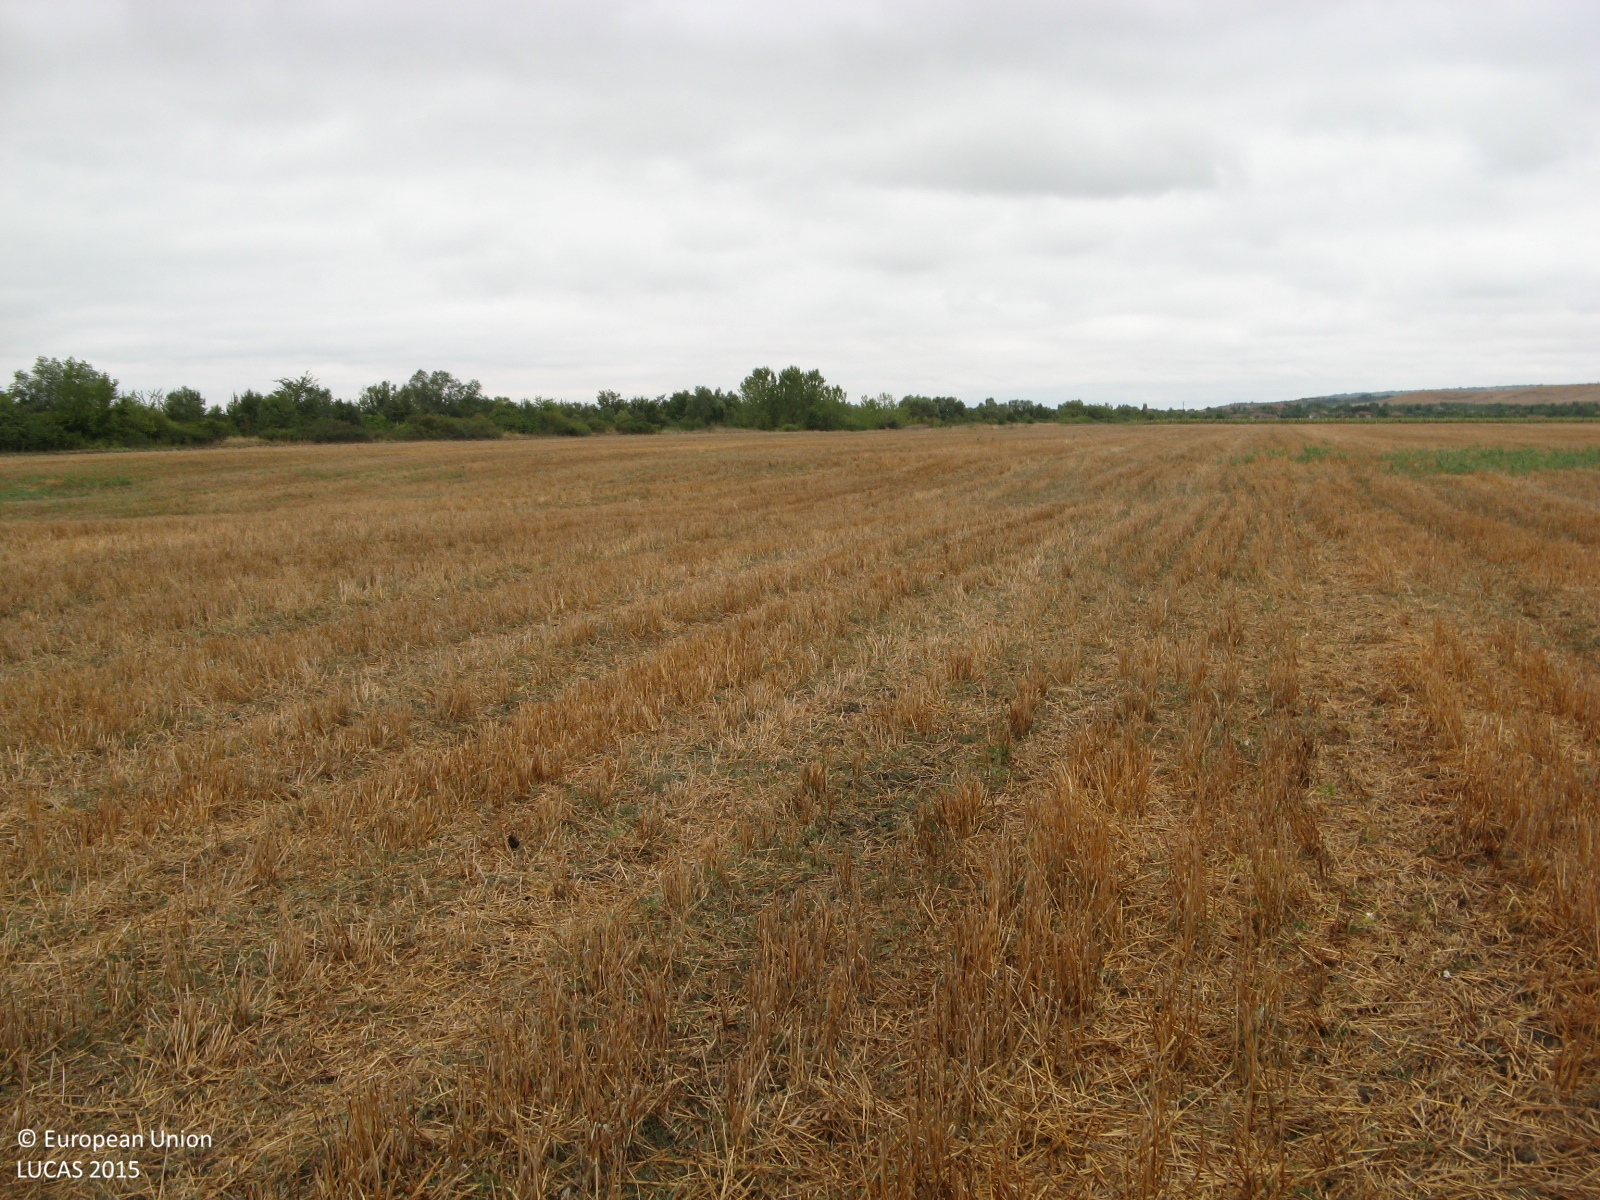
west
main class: Cropland
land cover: Common wheat
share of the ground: > 75 %
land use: Agriculture (excluding fallow land and kitchen gardens)
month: August
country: BG
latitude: 43.3460
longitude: 25.2355
